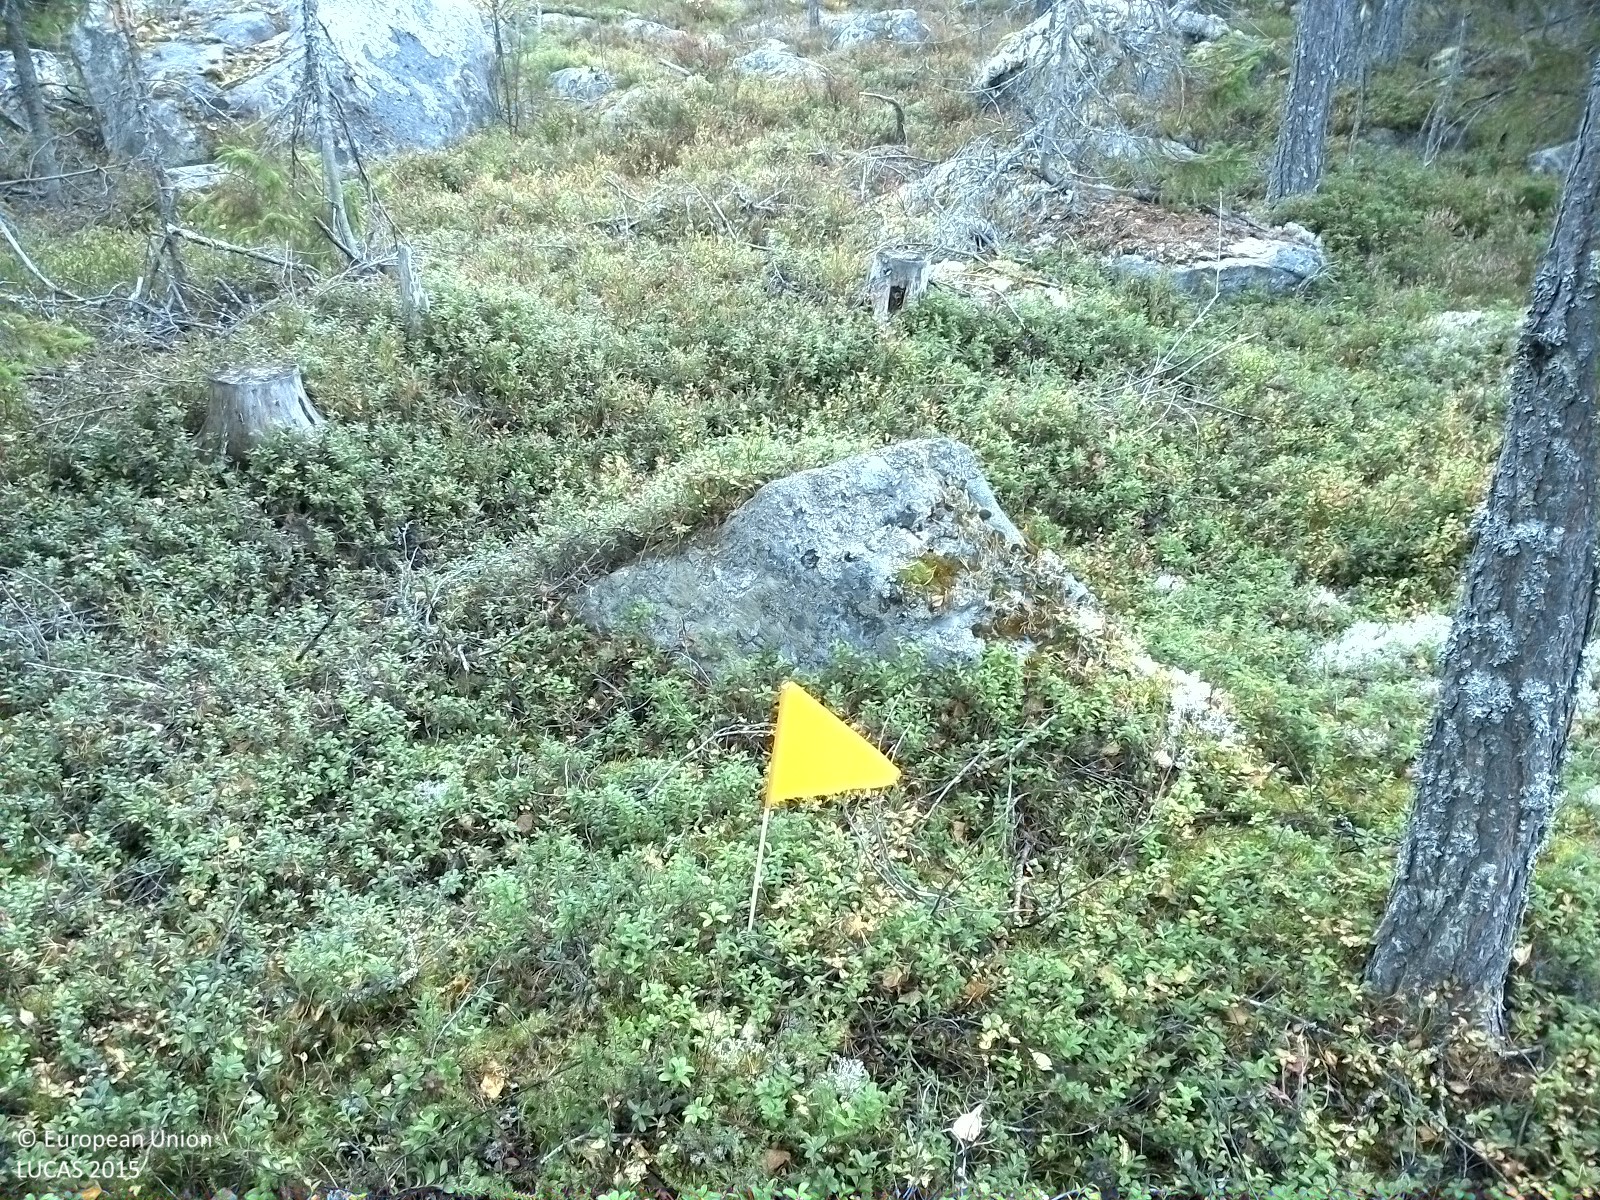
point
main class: Woodland
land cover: Other mixed woodland
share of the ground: 25 - 50 %
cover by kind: shrubs 65 %, coniferous forest trees 25 %, broadleaved forest trees 10 %
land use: Forestry
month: September
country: SE
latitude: 61.9951
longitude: 17.4092
